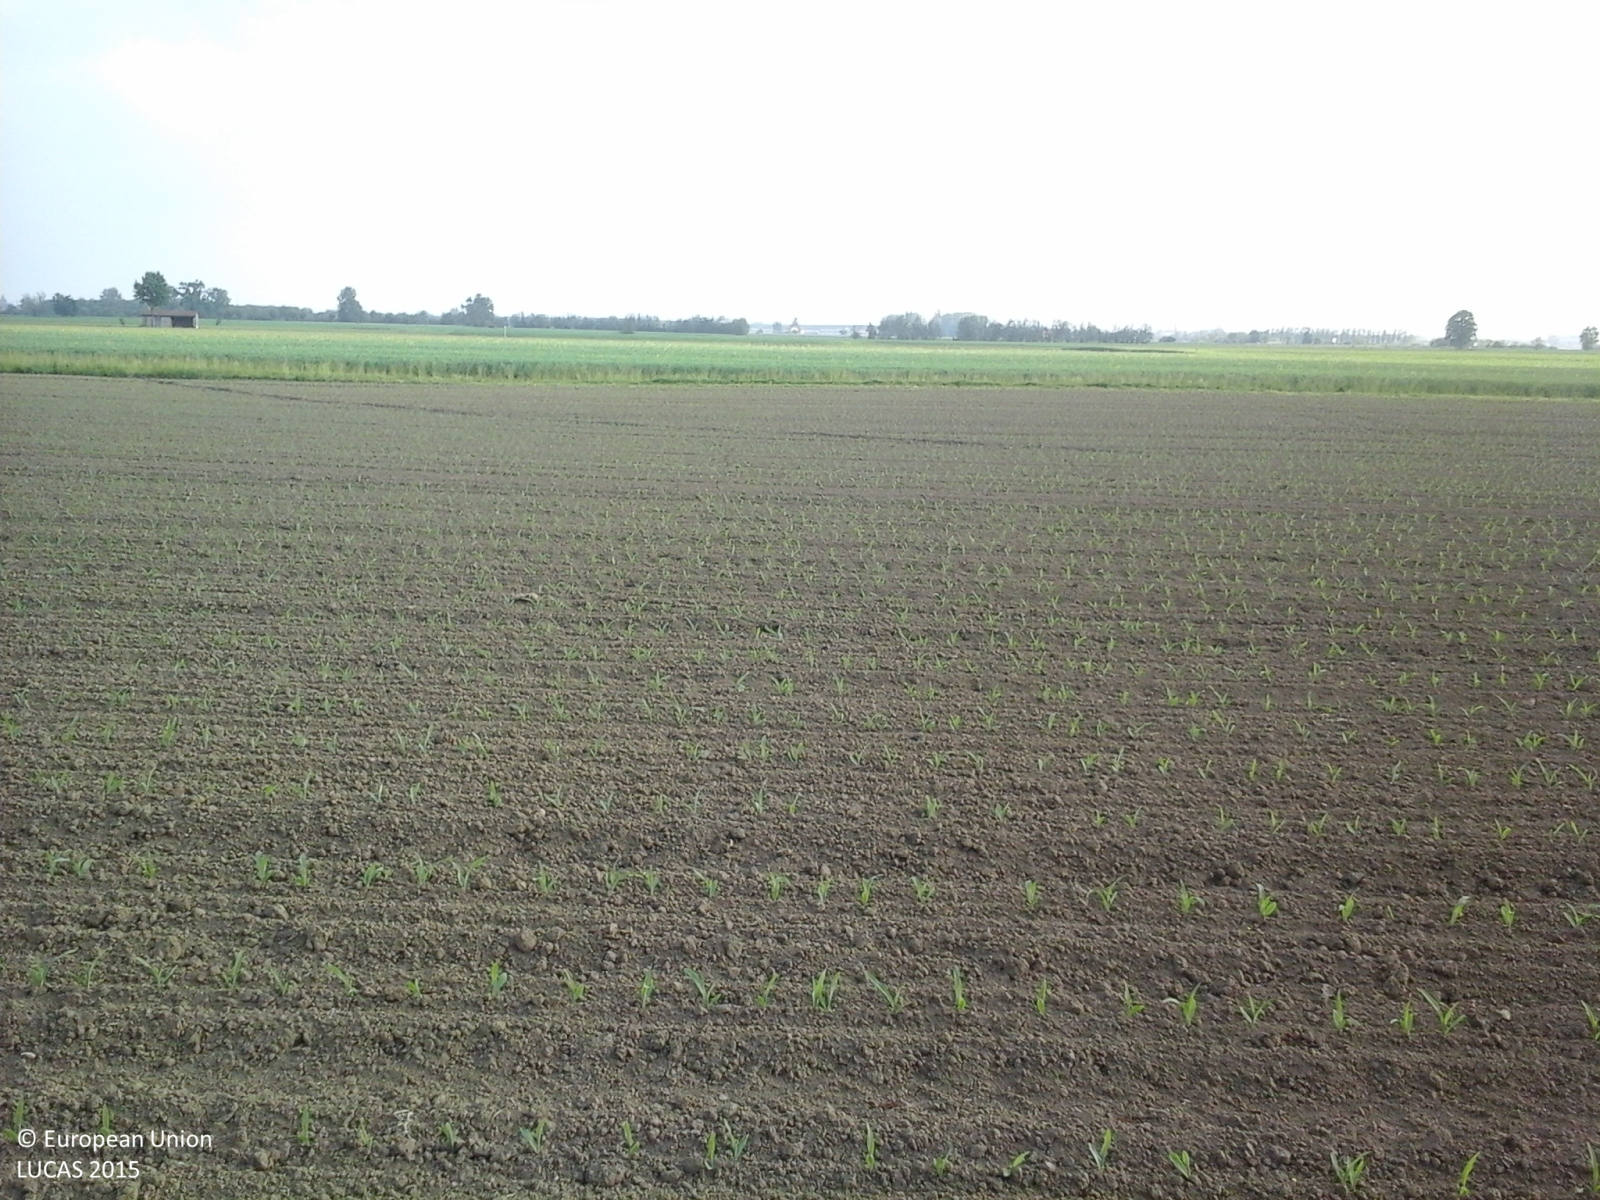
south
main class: Cropland
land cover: Maize
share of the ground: < 10 %
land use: Agriculture (excluding fallow land and kitchen gardens)
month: May
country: IT
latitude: 45.0350
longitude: 10.3927
